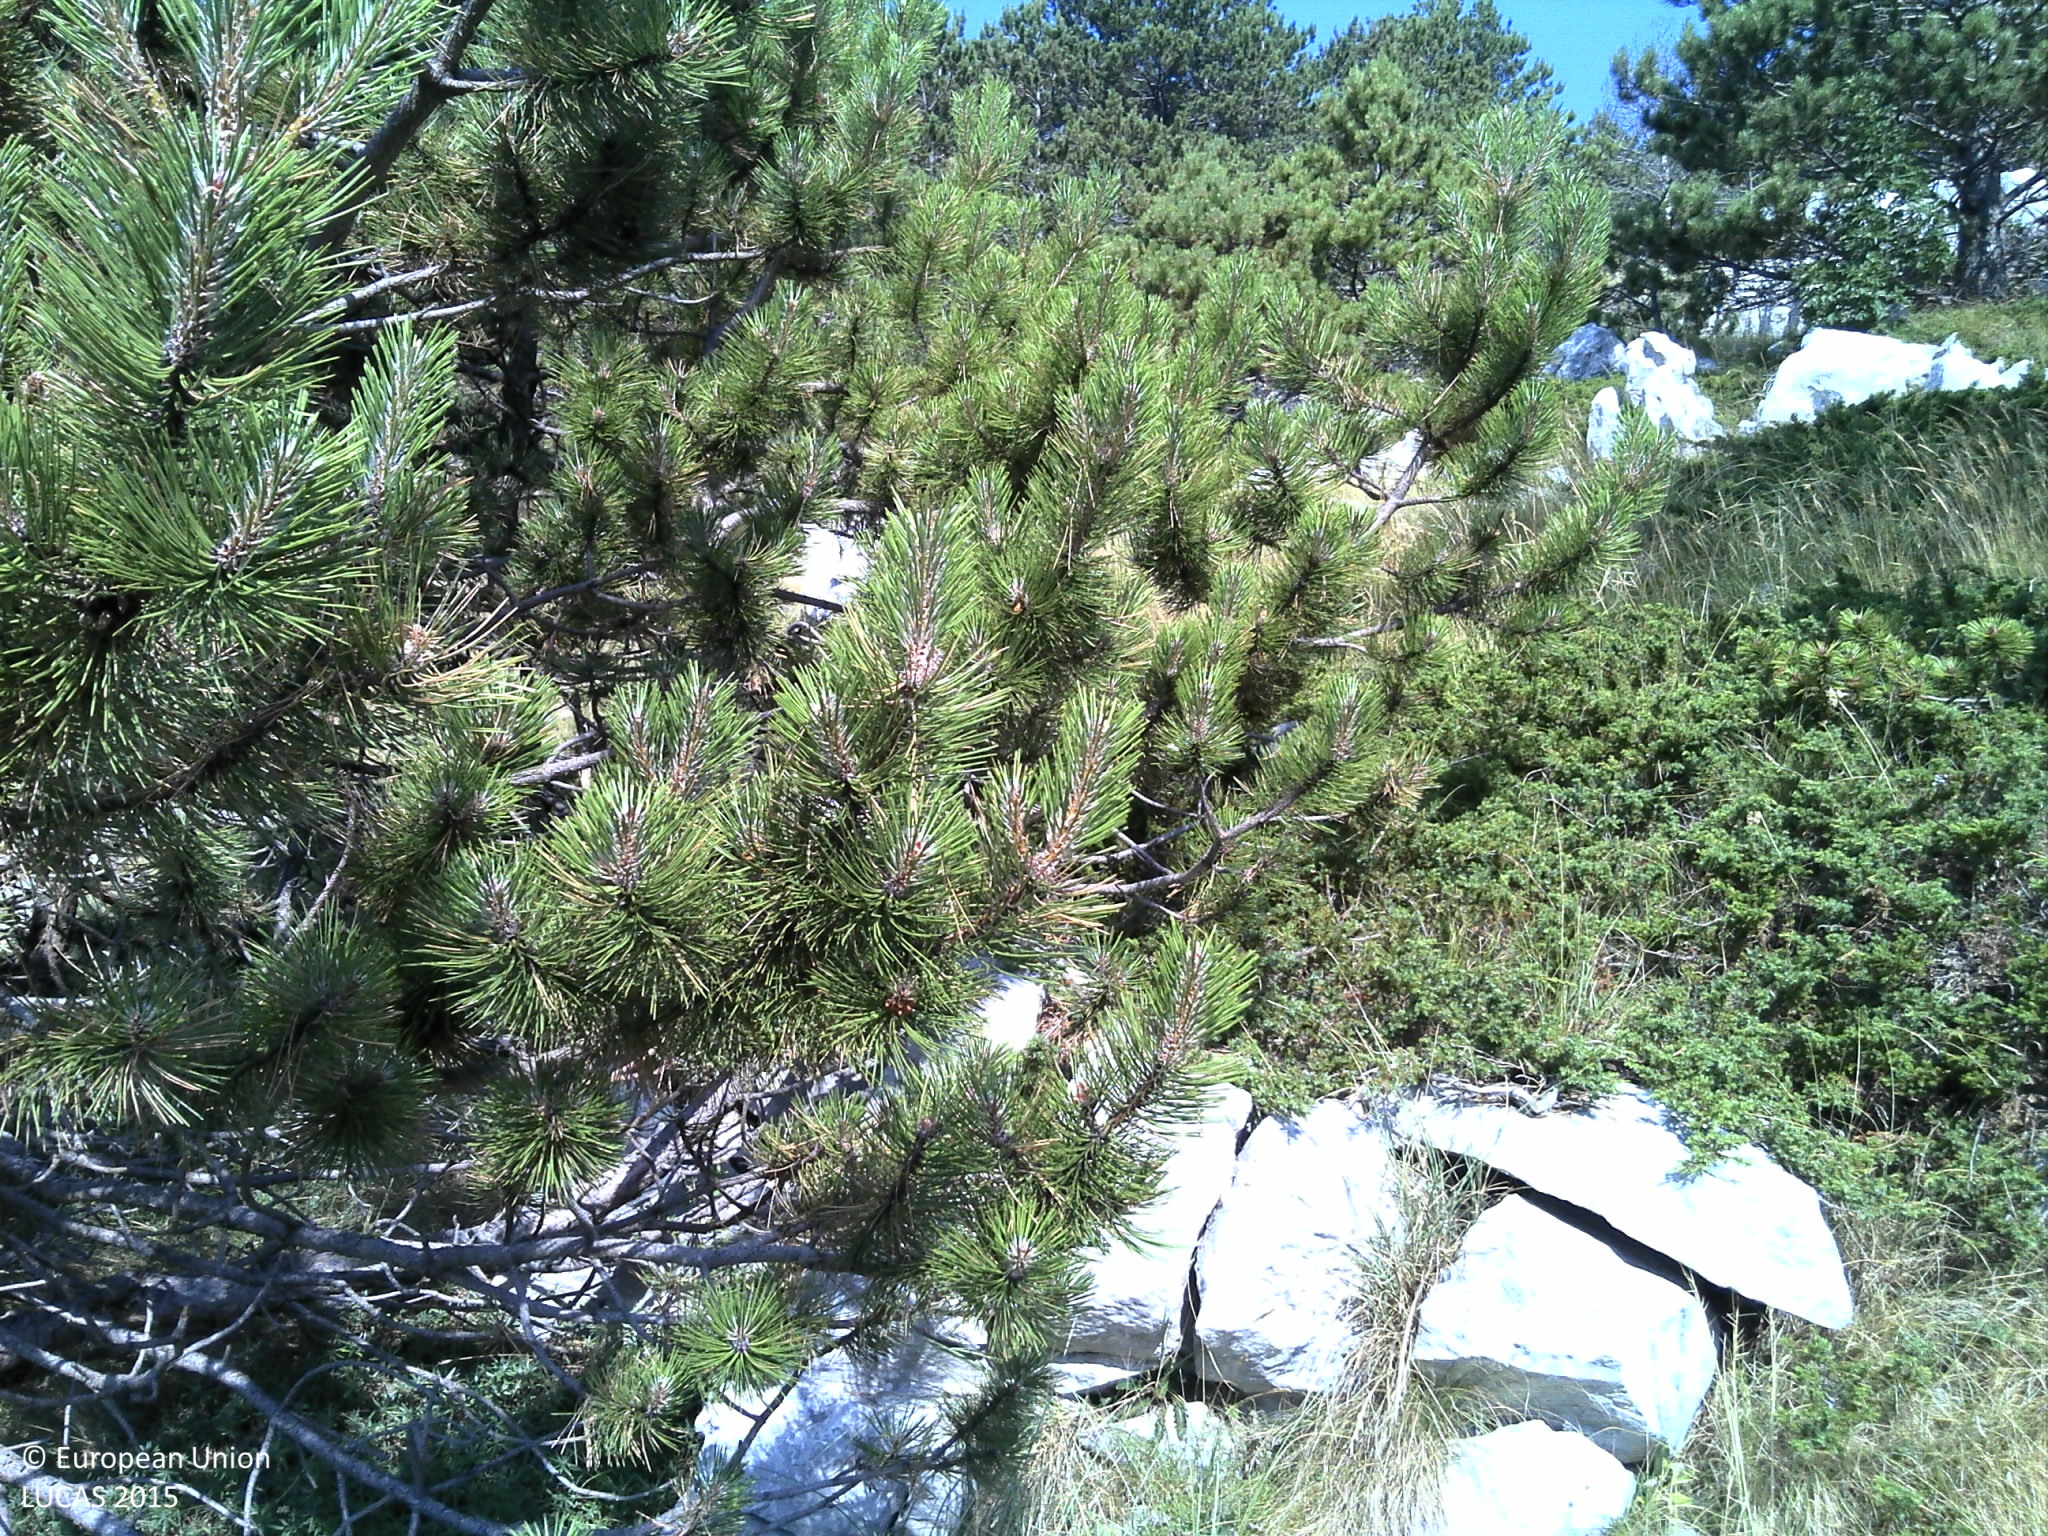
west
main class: Woodland
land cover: Pine dominated coniferous woodland
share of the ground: 10 - 25 %
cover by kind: herbaceous plants 60 %, coniferous forest trees 15 %, shrubs 10 %, unconsolidated bare surface 10 %, consolidated bare surface 5 %
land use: Semi-natural and natural areas not in use
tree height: > 5 m
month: August
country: HR
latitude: 43.2940
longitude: 17.0782
